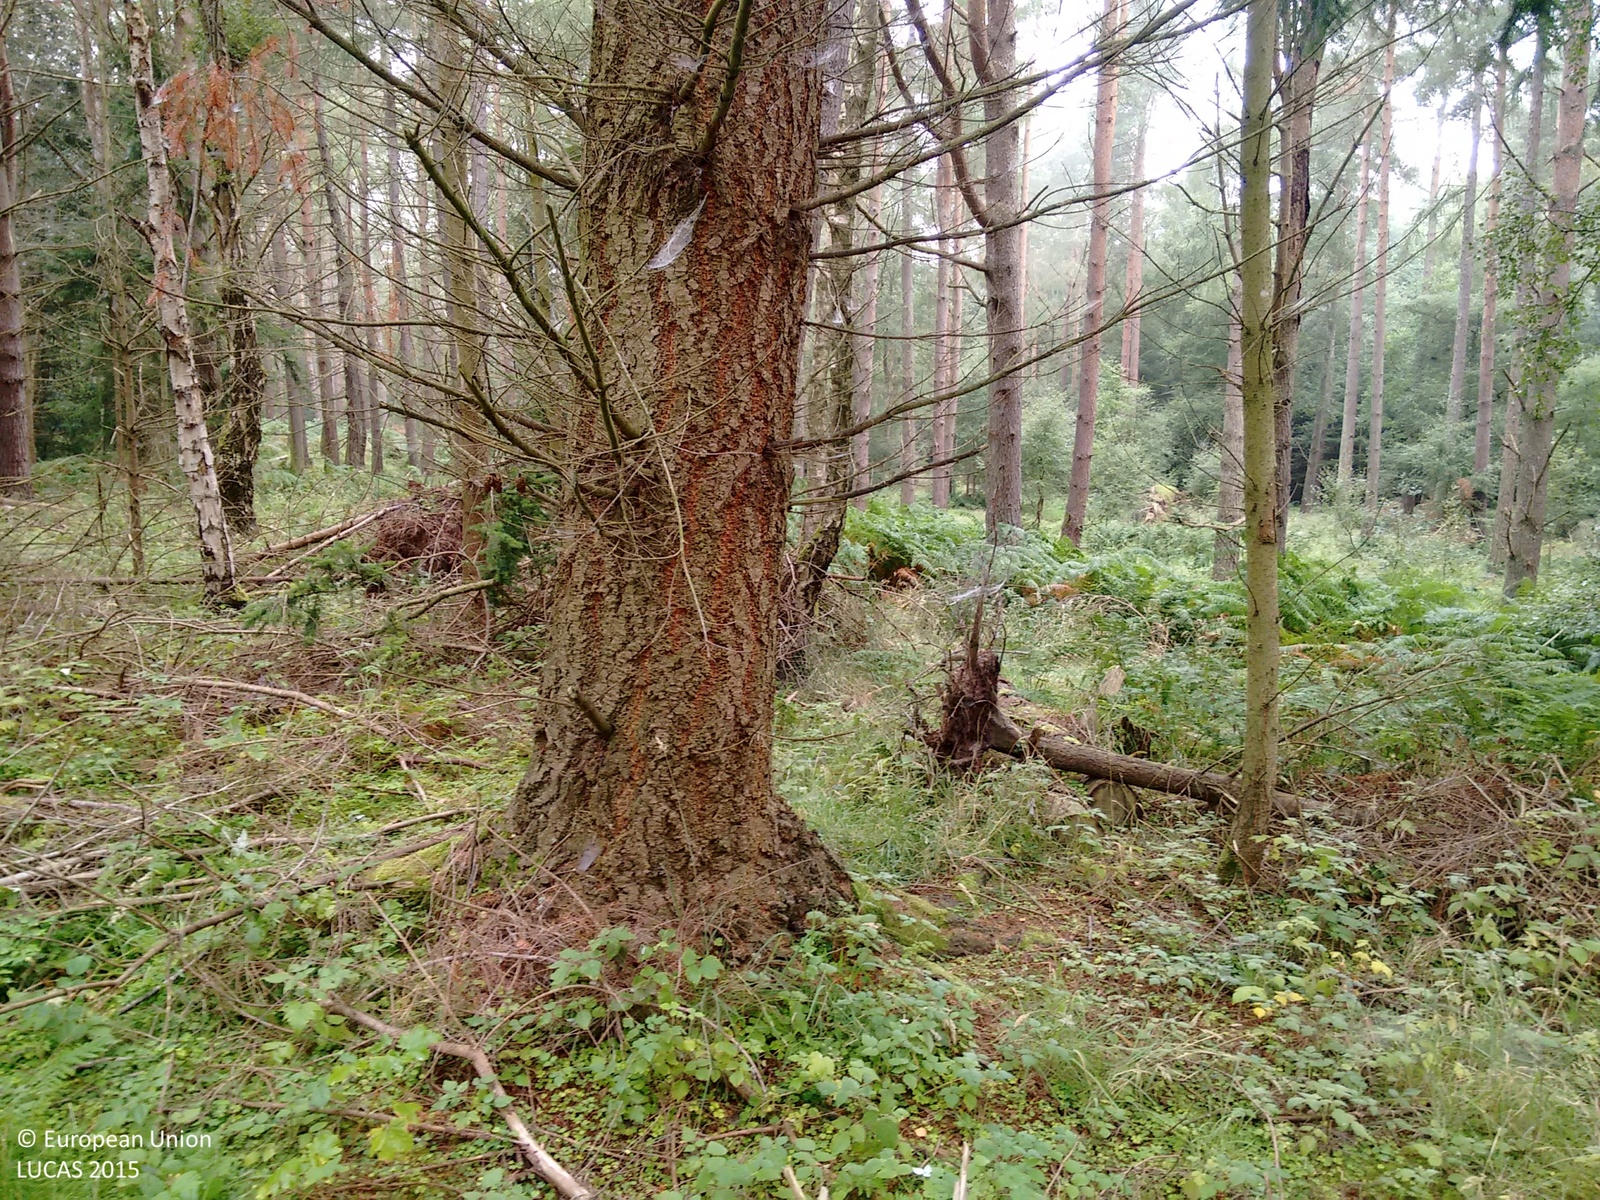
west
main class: Woodland
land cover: Spruce dominated coniferous woodland
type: exotic forest
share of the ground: > 75 %
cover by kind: coniferous forest trees 80 %, herbaceous plants 10 %, broadleaved forest trees 5 %, lichens and mosses 5 %
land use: Forestry
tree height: > 5 m
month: September
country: GB
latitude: 57.5300
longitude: -3.8895
